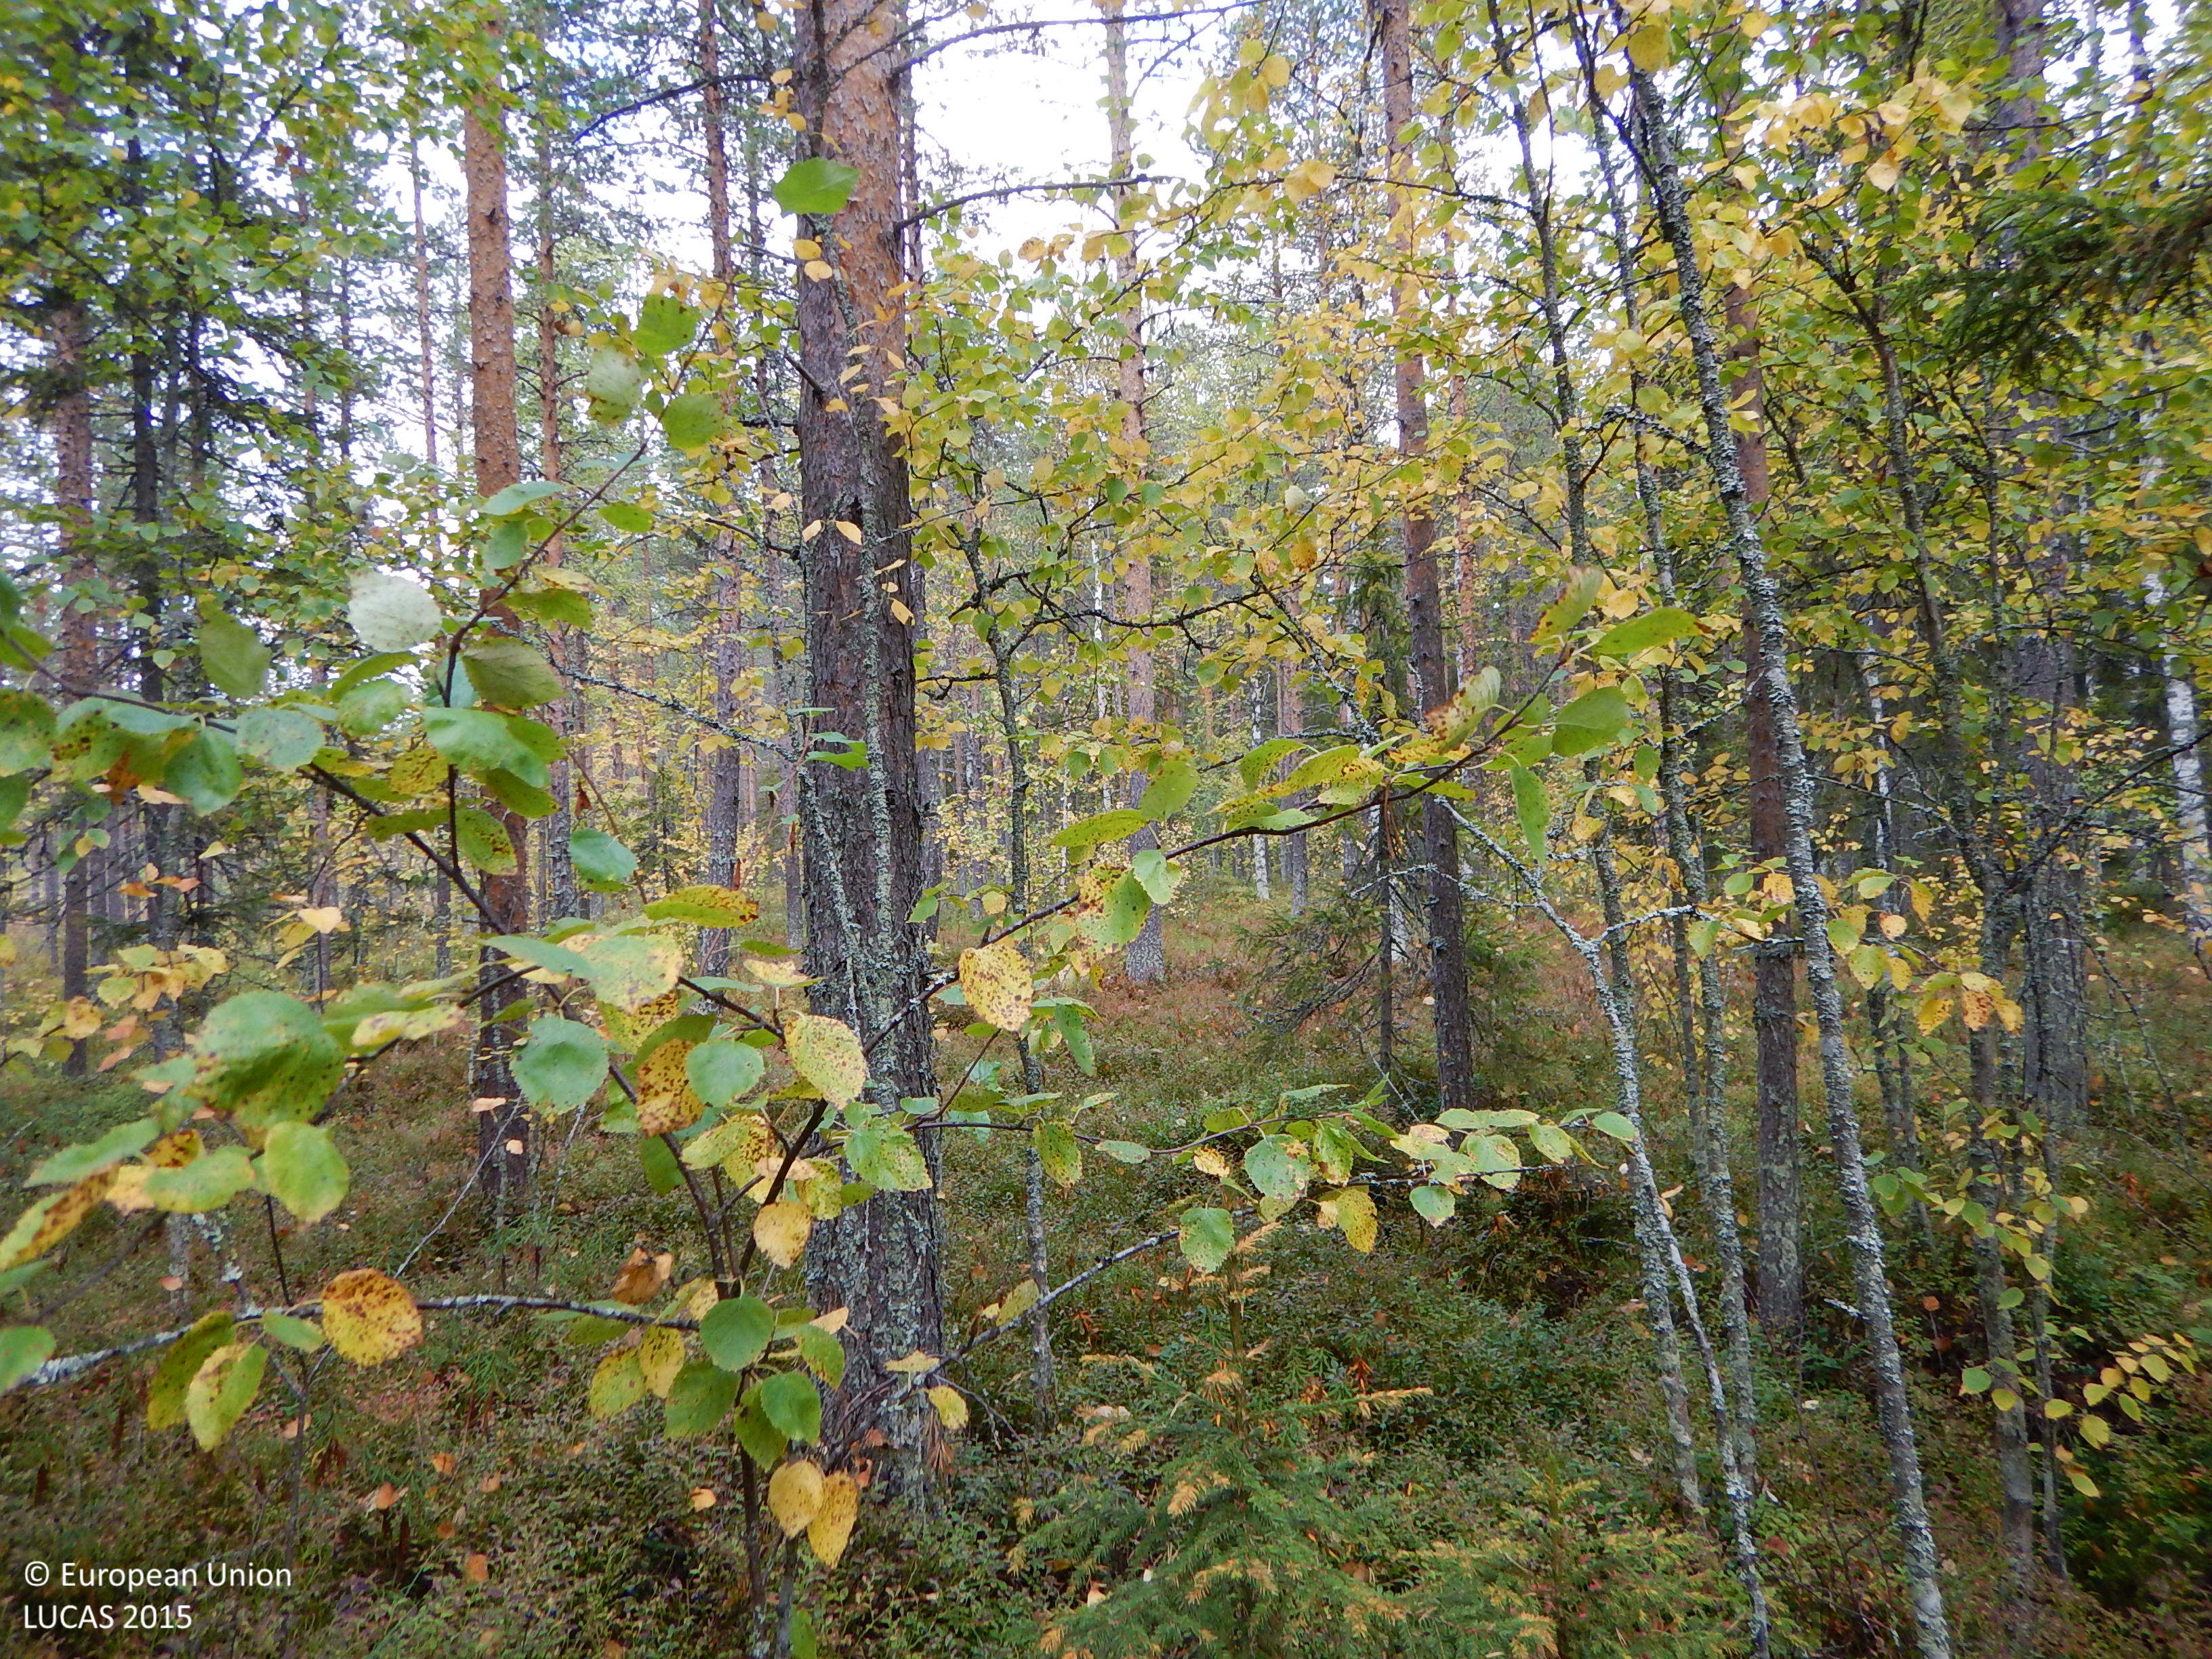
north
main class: Woodland
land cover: Pine dominated mixed woodland
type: boreal forest
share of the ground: 50 - 75 %
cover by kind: coniferous forest trees 40 %, shrubs 20 %, broadleaved forest trees 15 %, lichens and mosses 15 %, herbaceous plants 10 %
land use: Forestry
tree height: > 5 m
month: September
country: SE
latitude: 64.8384
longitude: 19.8564
